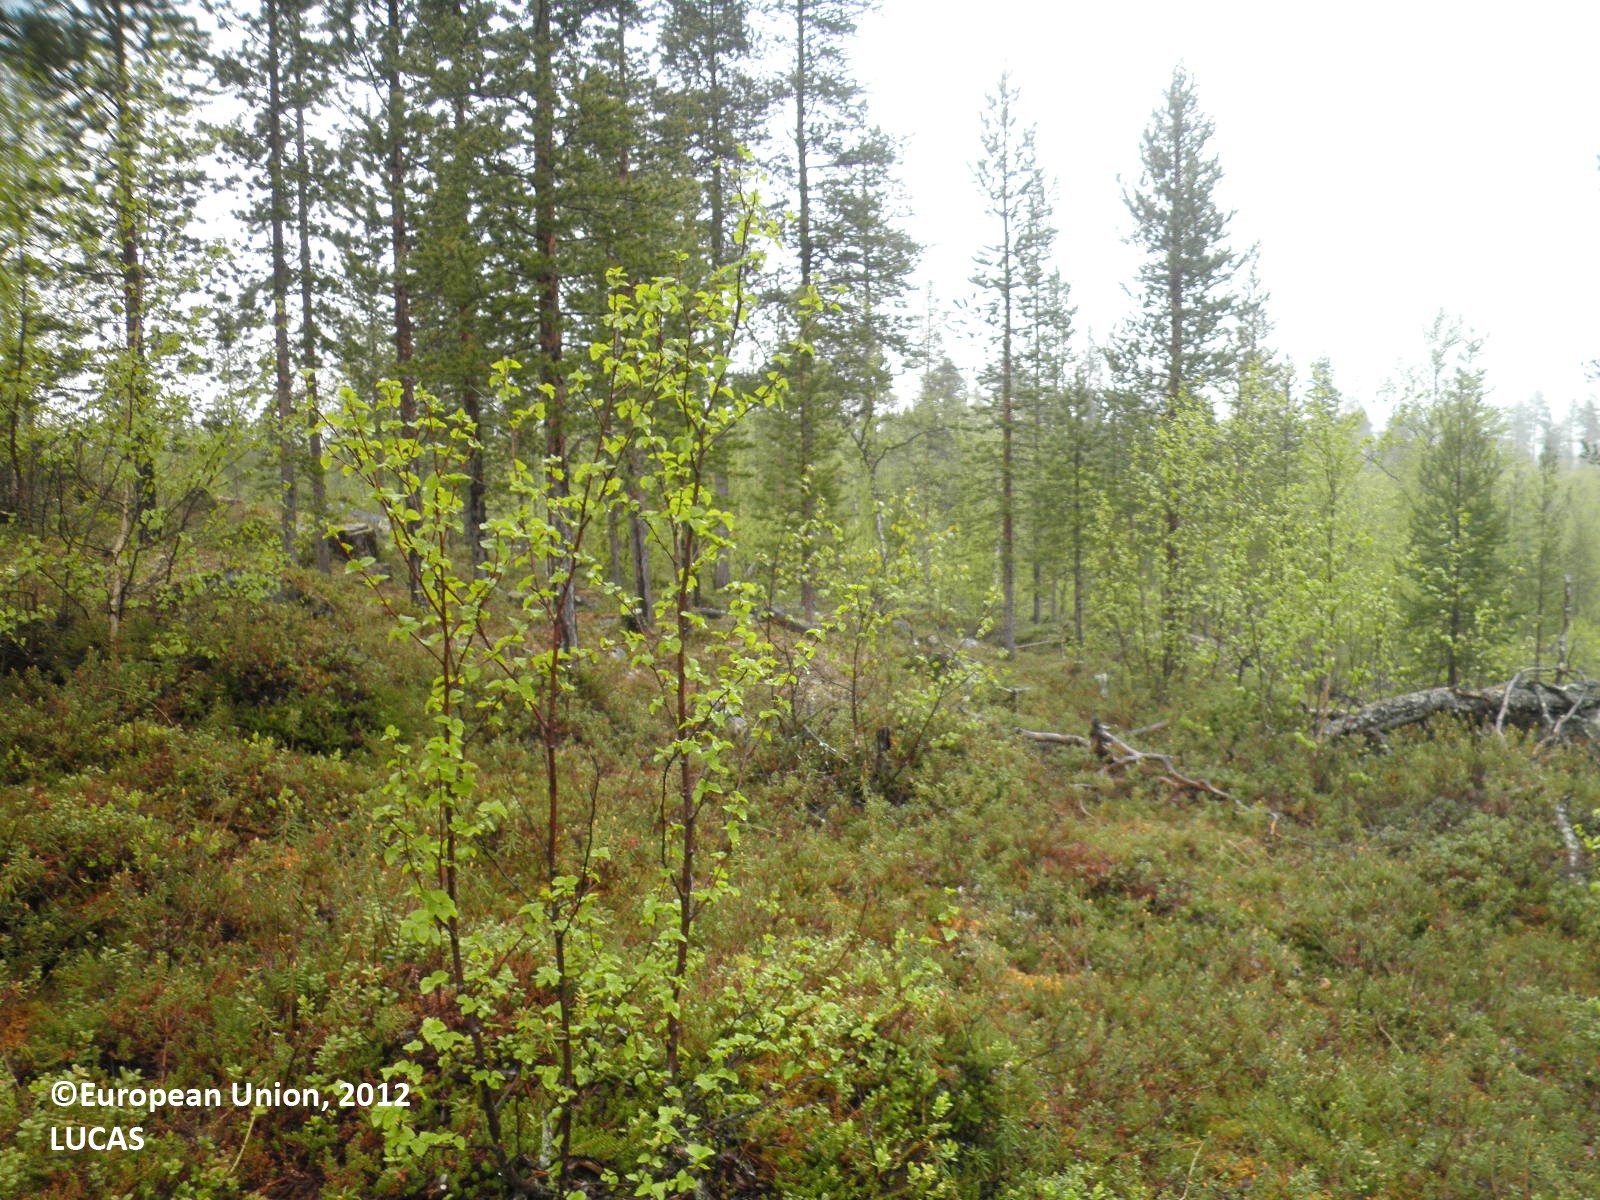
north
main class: Woodland
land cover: Pine dominated mixed woodland
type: boreal forest
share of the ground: 25 - 50 %
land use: Forestry
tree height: > 5 m
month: June
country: FI
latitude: 68.8759
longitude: 26.7879
